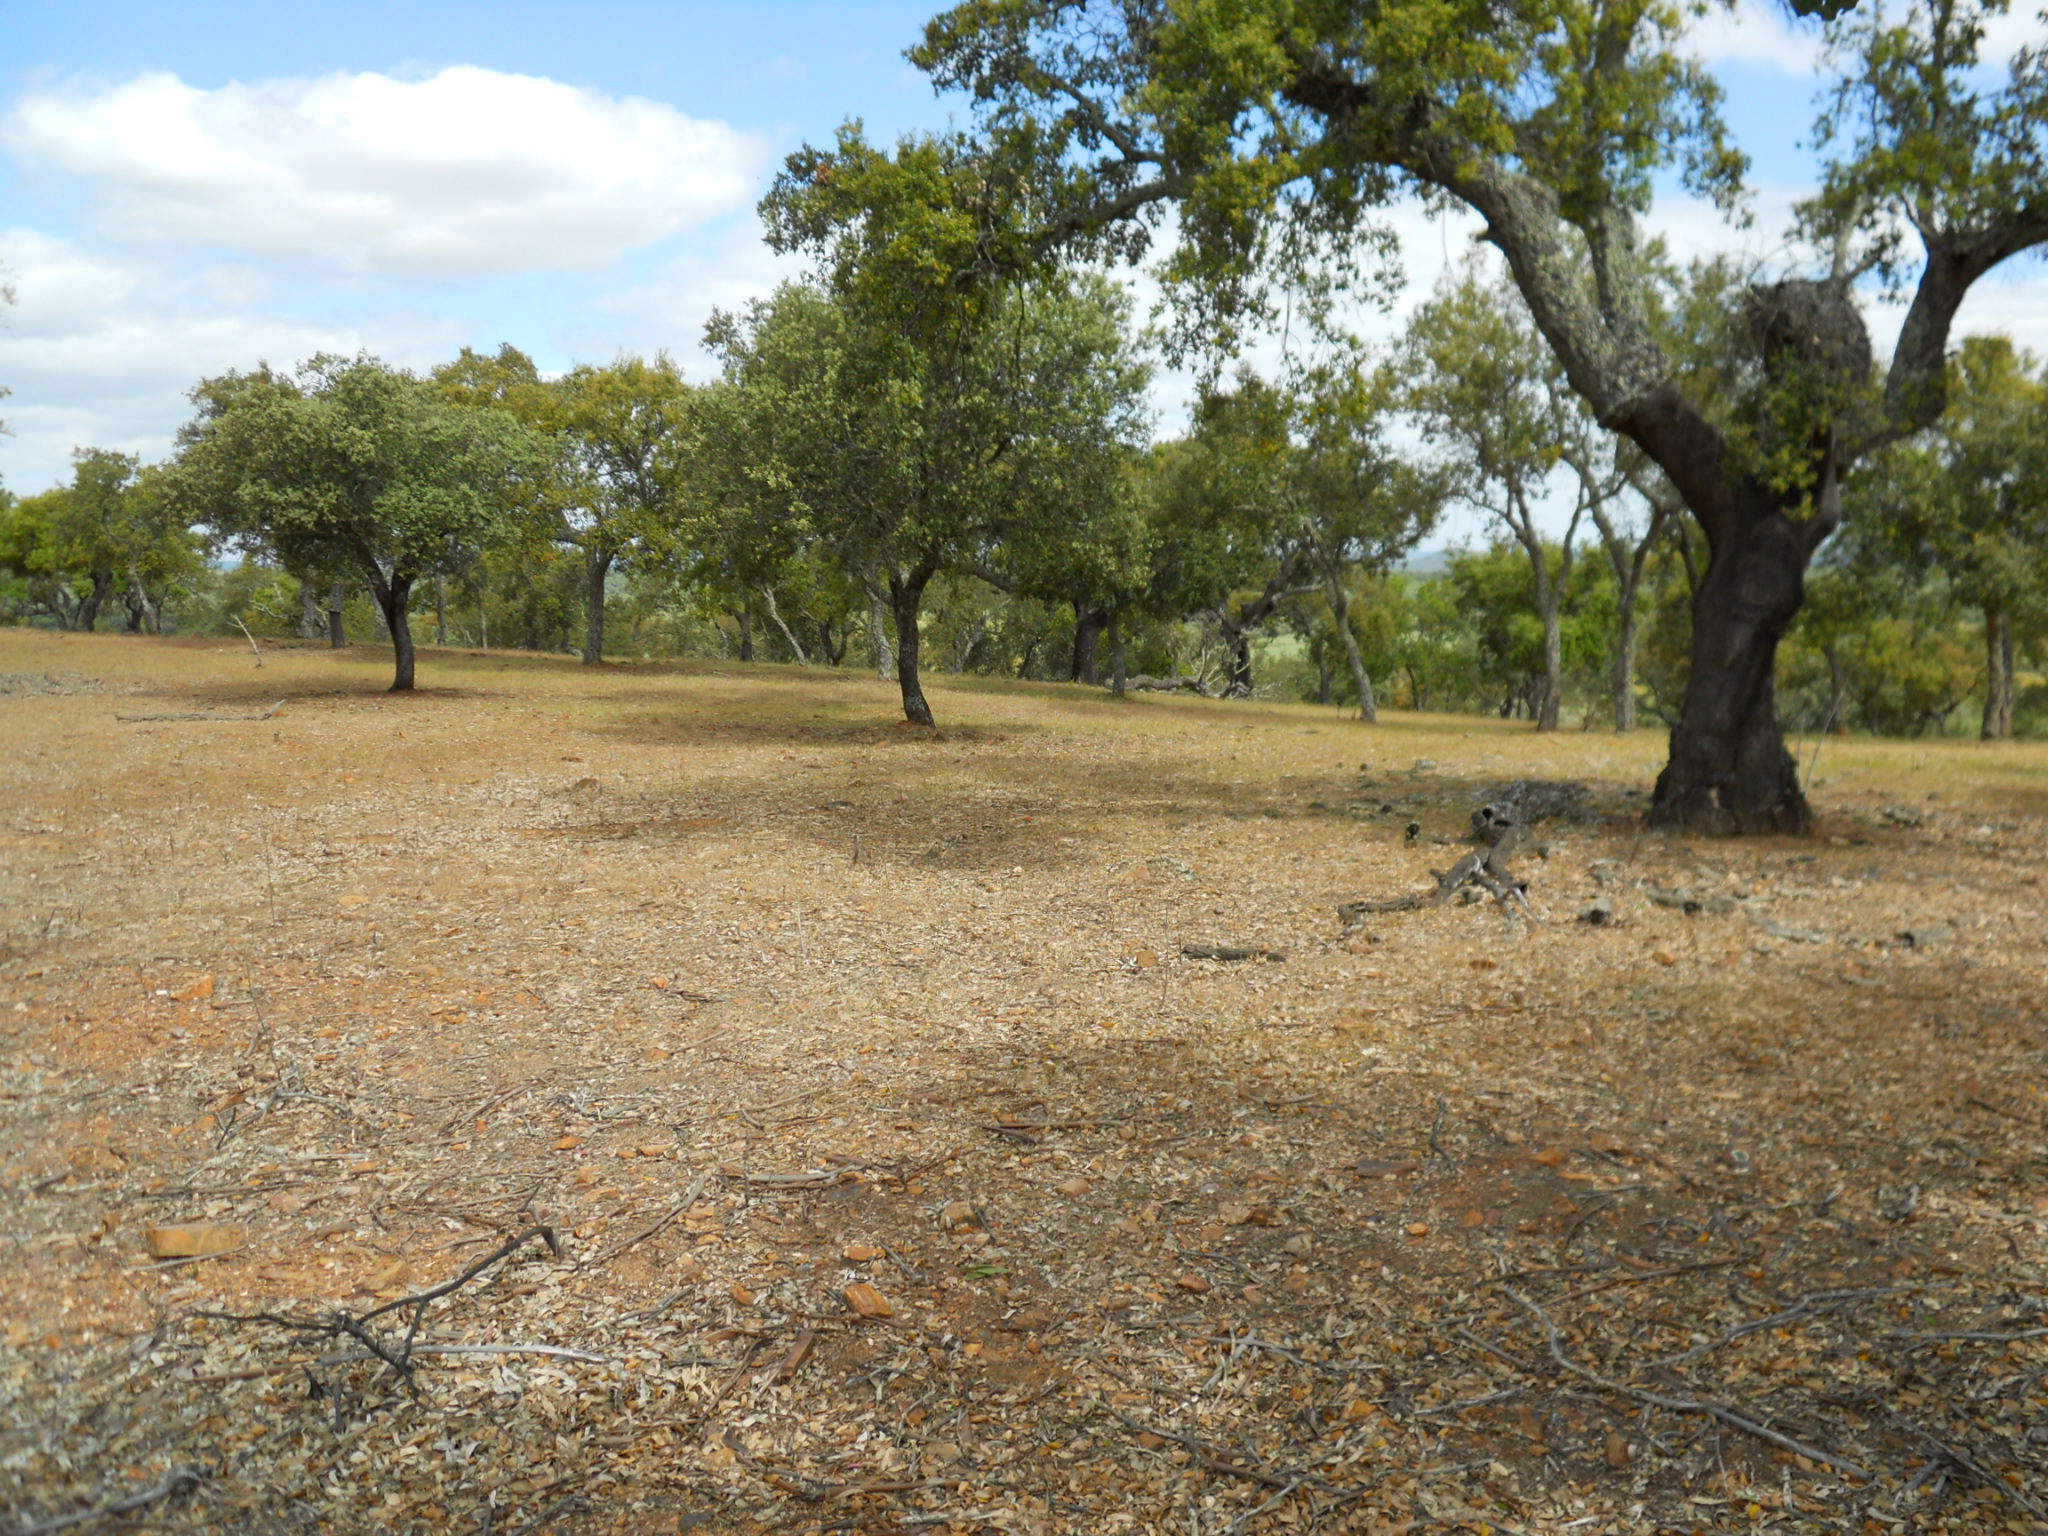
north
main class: Woodland
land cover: Broadleaved woodland
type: broadleaved evergreen forest
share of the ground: > 75 %
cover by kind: broadleaved forest trees 90 %, unconsolidated bare surface 10 %
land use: Forestry
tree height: > 5 m
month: May
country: ES
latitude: 39.1631
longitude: -7.0786
